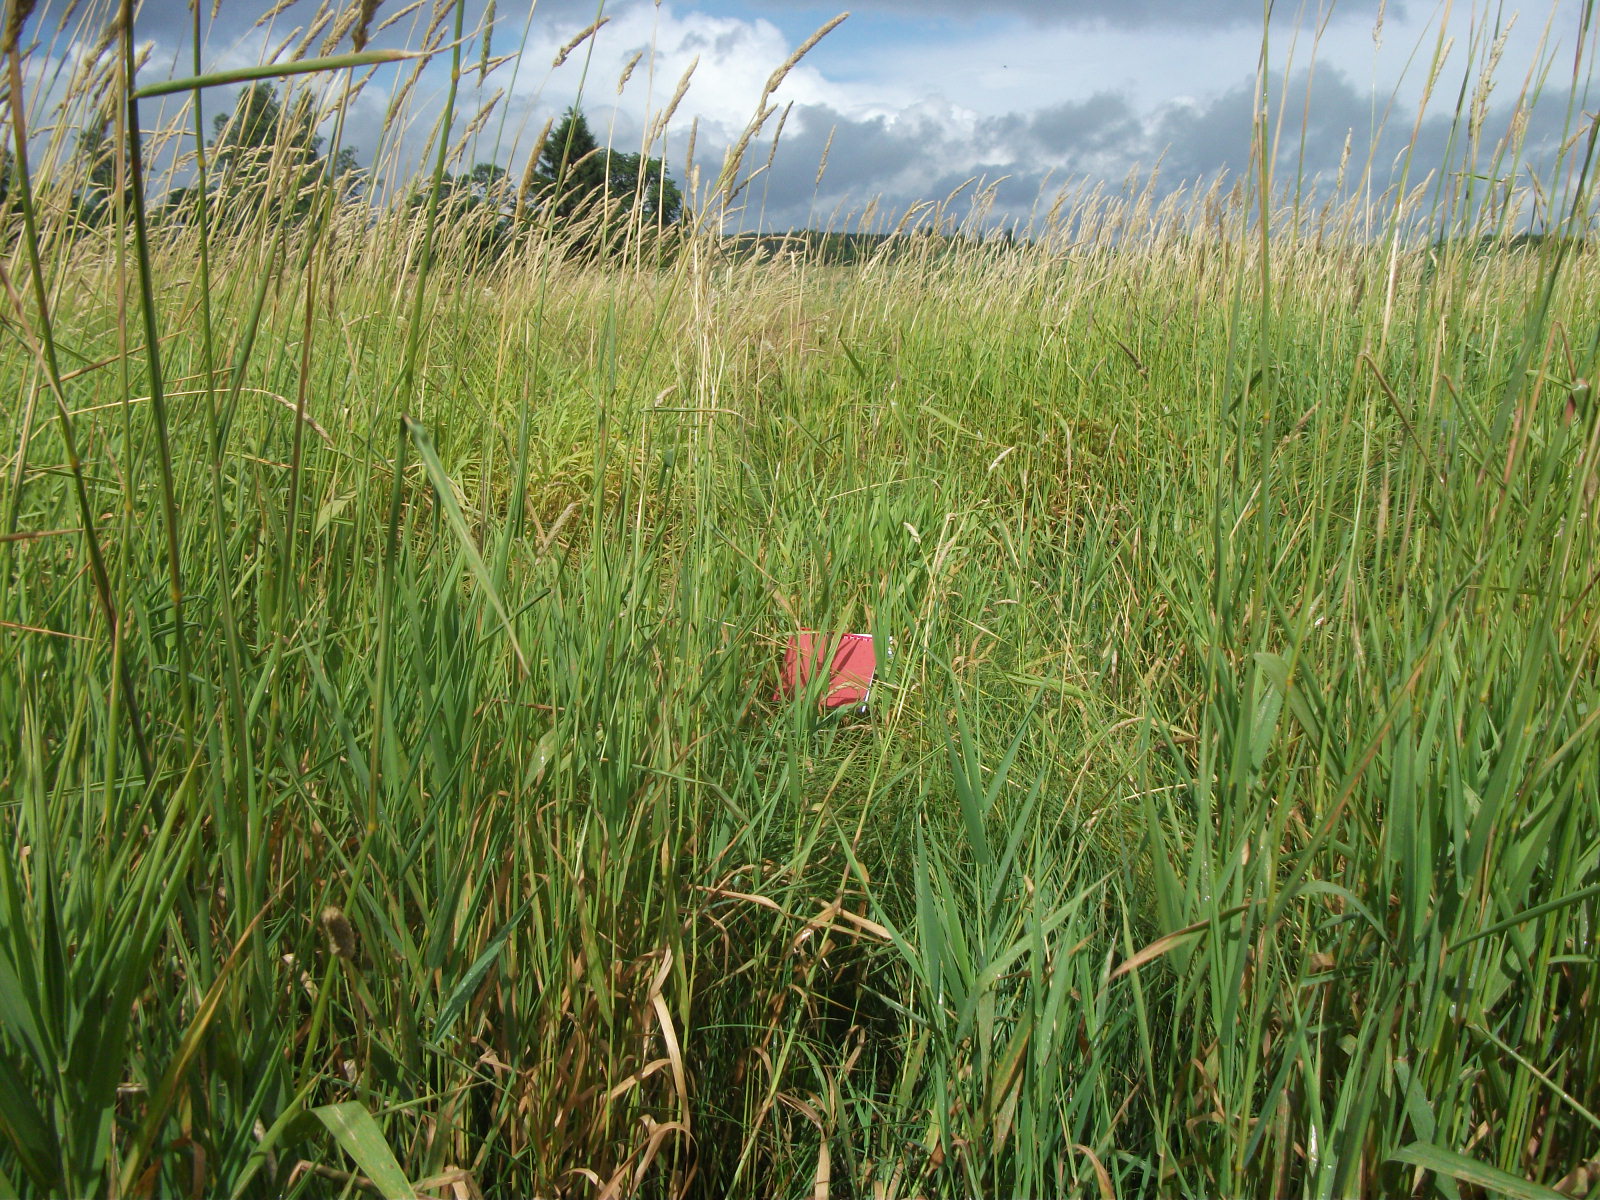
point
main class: Grassland
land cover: Grassland without tree/shrub cover
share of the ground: > 75 %
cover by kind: herbaceous plants 100 %
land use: Agriculture (excluding fallow land and kitchen gardens)
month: July
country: LV
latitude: 57.0078
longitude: 25.8860
